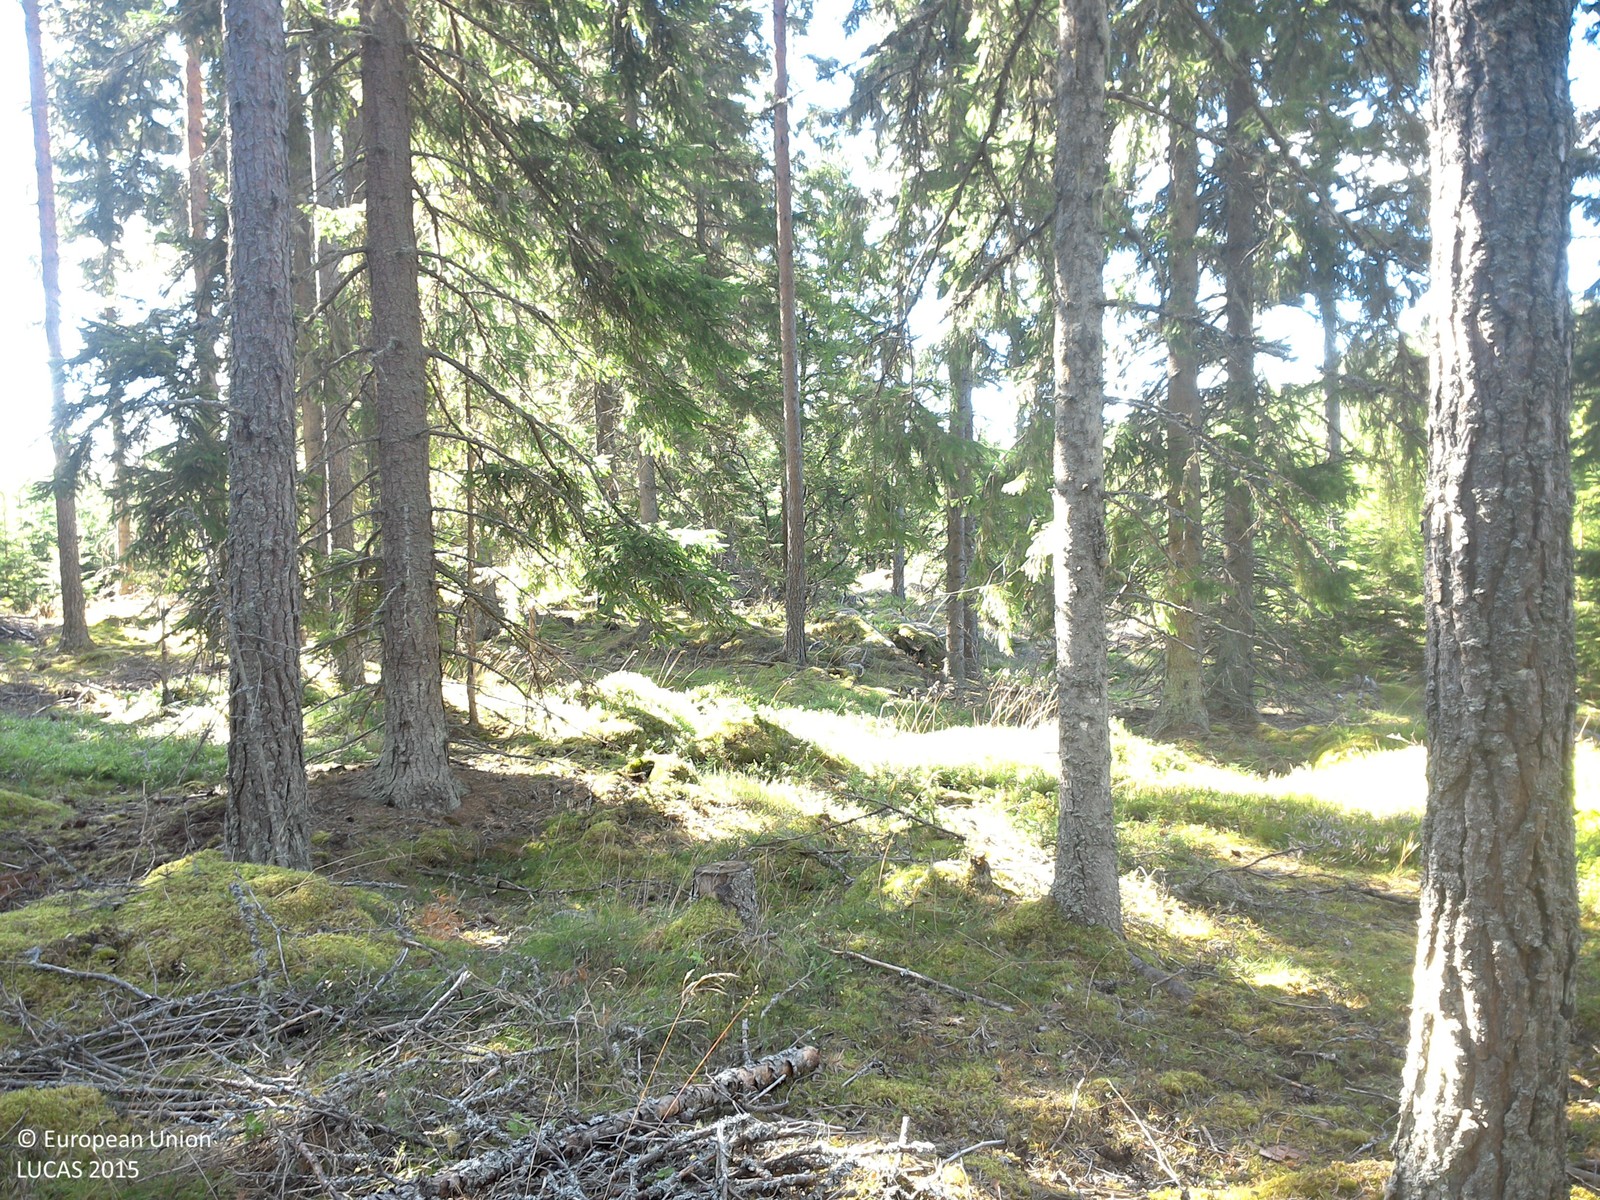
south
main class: Woodland
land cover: Pine dominated coniferous woodland
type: boreal forest
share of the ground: 25 - 50 %
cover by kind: coniferous forest trees 40 %, lichens and mosses 40 %, herbaceous plants 20 %
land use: Forestry
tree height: > 5 m
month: August
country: SE
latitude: 57.8804
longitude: 15.3074
